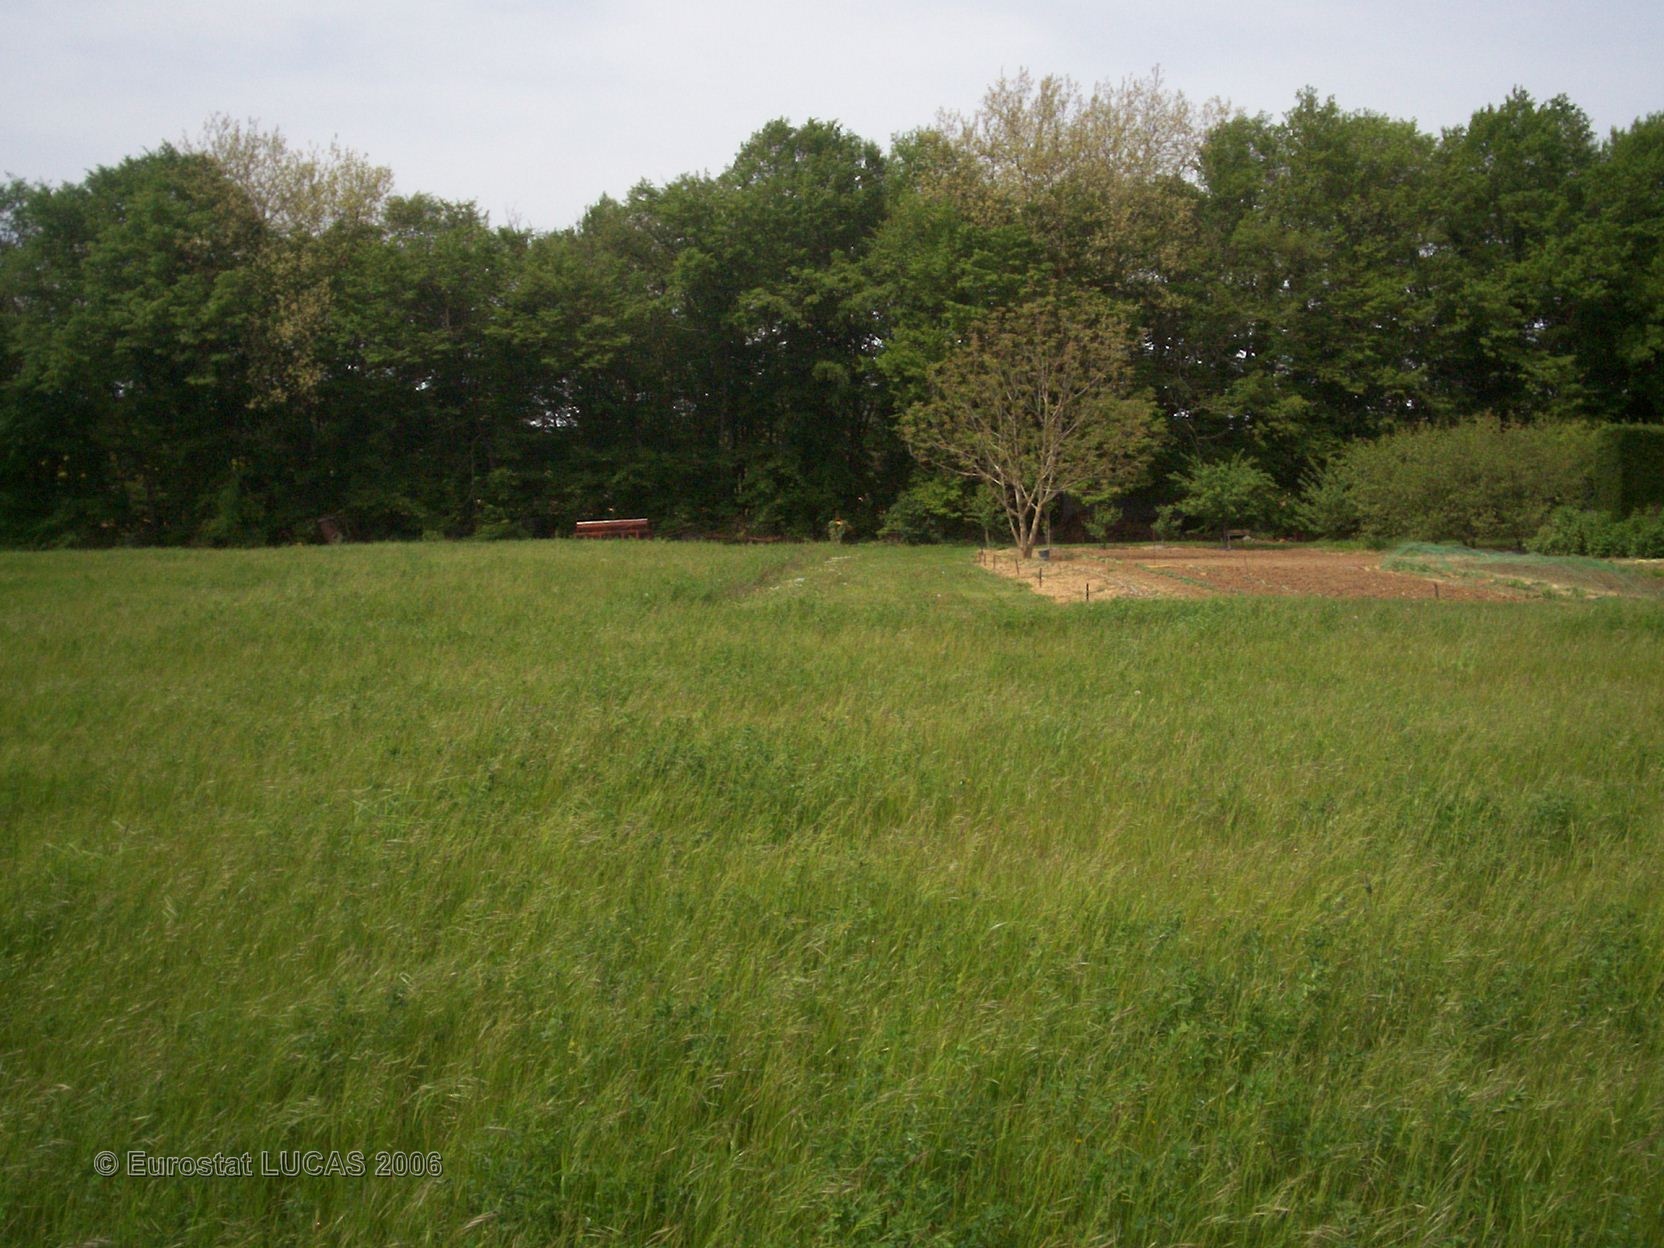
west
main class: Grassland
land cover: Grassland without tree/shrub cover
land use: Agriculture (excluding fallow land and kitchen gardens)
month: May
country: FR
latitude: 46.5596
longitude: 0.4727
